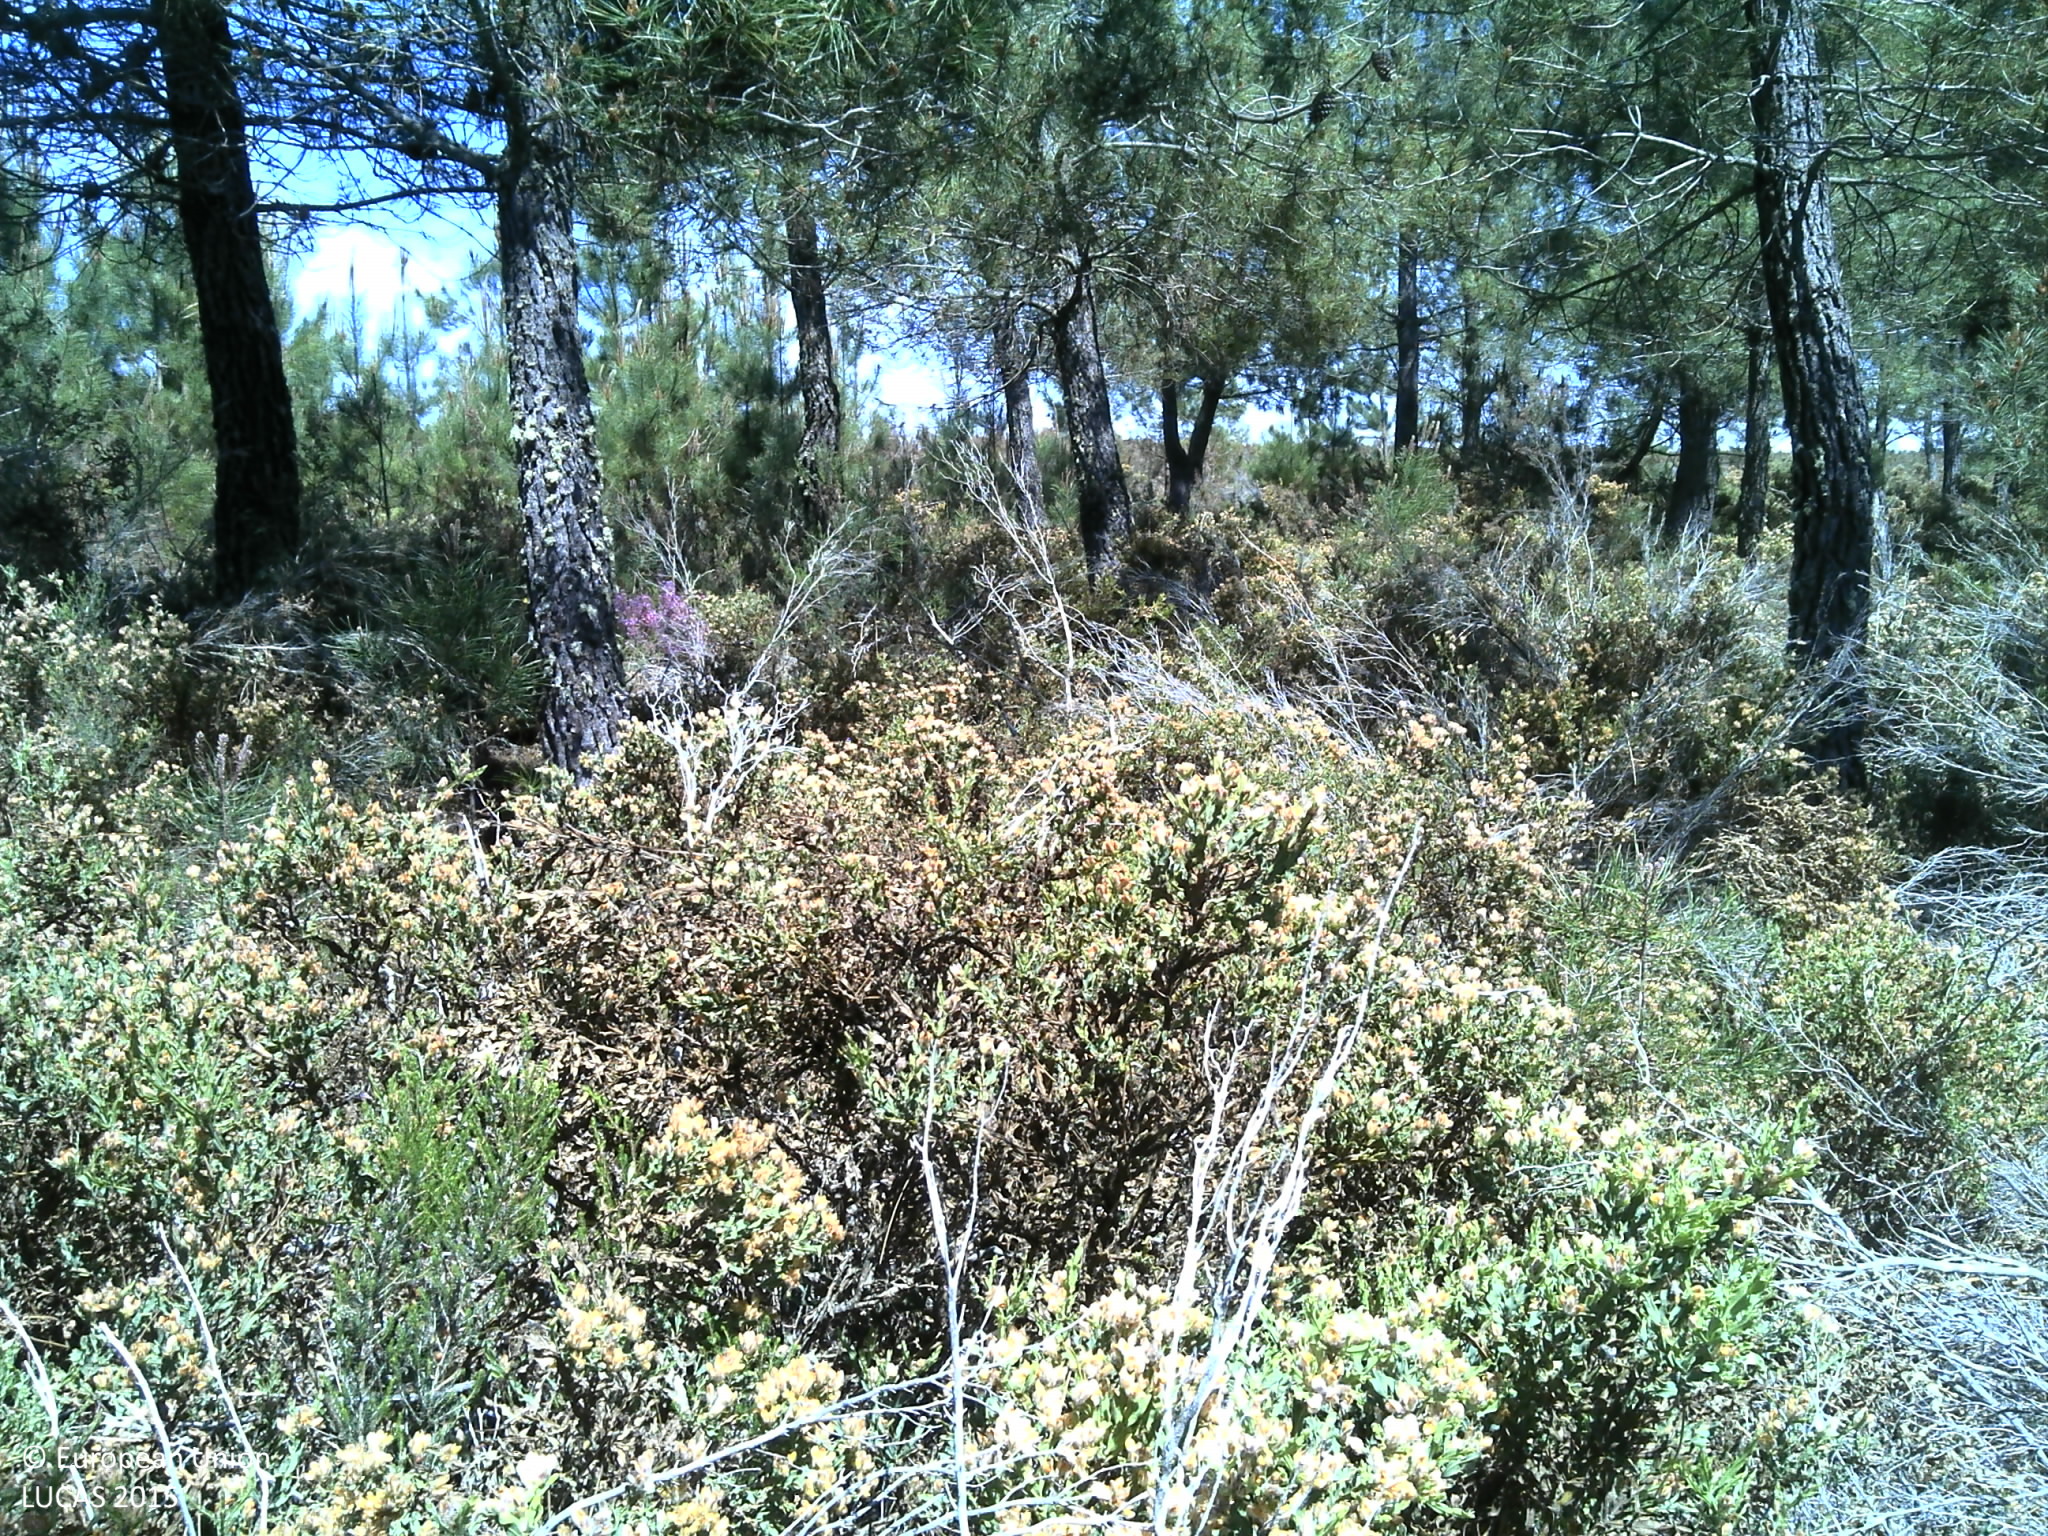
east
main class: Woodland
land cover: Pine dominated coniferous woodland
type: coniferous forest of the mediterranean region
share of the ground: 10 - 25 %
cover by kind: shrubs 60 %, coniferous forest trees 20 %, consolidated bare surface 10 %, unconsolidated bare surface 10 %
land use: Forestry
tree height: > 5 m
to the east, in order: Pine dominated coniferous woodland; Grass margins; Tracks; Shrubland without tree cover; Shrubland with sparse tree cover; Shrubland without tree cover
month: May
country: PT
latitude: 41.9102
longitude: -6.6405
